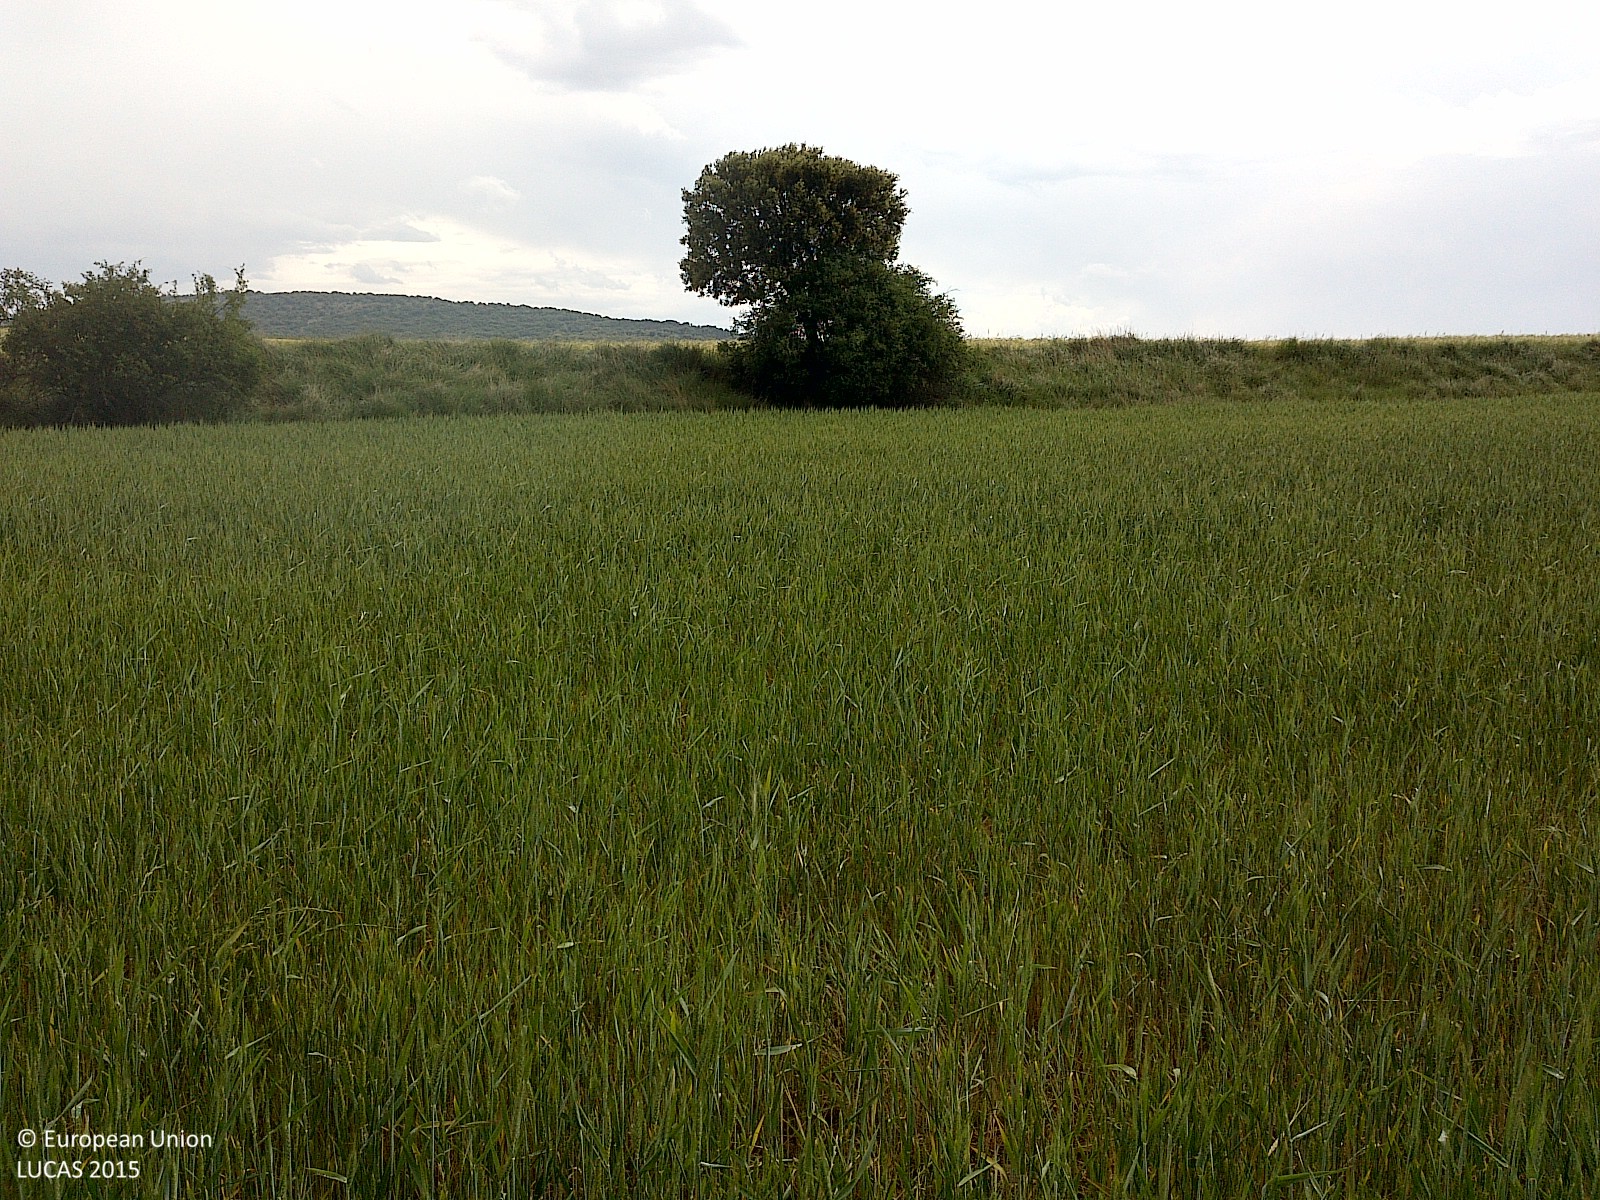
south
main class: Cropland
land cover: Common wheat
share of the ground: > 75 %
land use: Agriculture (excluding fallow land and kitchen gardens)
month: May
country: ES
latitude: 41.7949
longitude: -2.2749
